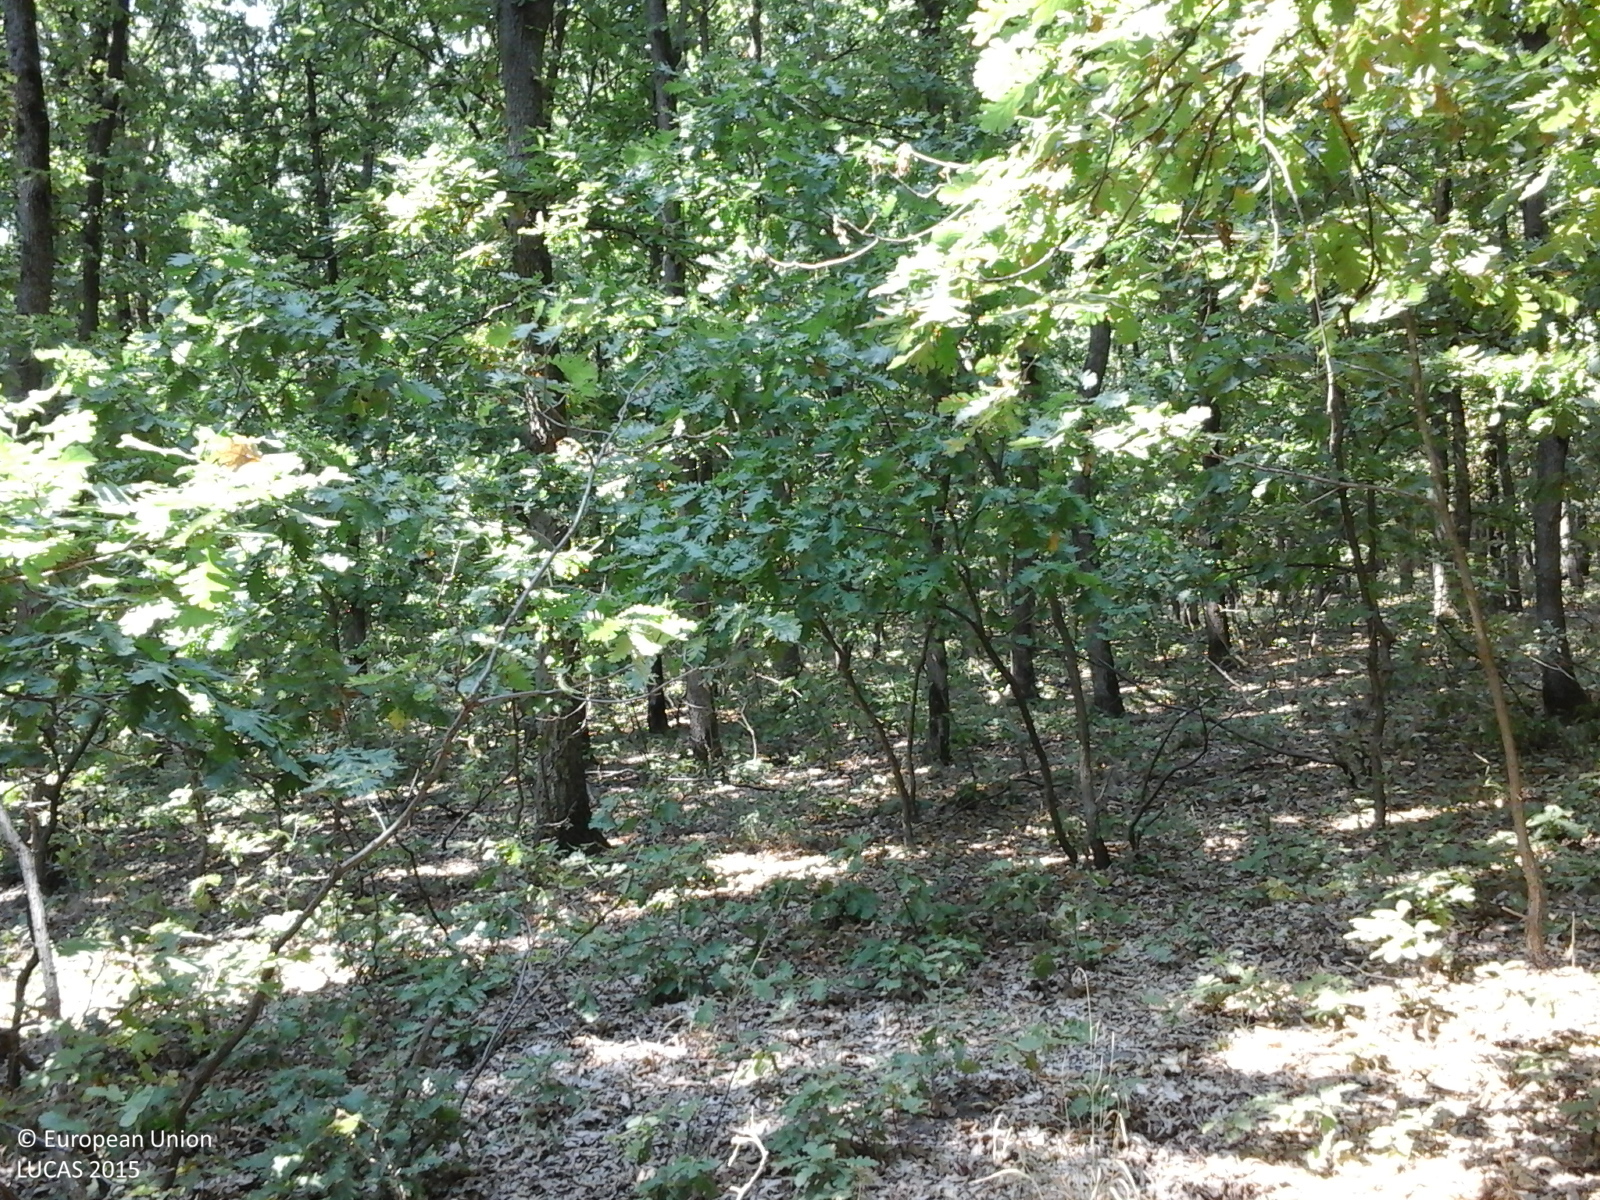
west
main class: Woodland
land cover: Broadleaved woodland
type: acidophilous oak and oak-birch forest
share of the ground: > 75 %
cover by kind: broadleaved forest trees 100 %
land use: Forestry
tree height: > 5 m
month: August
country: RO
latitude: 44.5082
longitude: 23.4745
